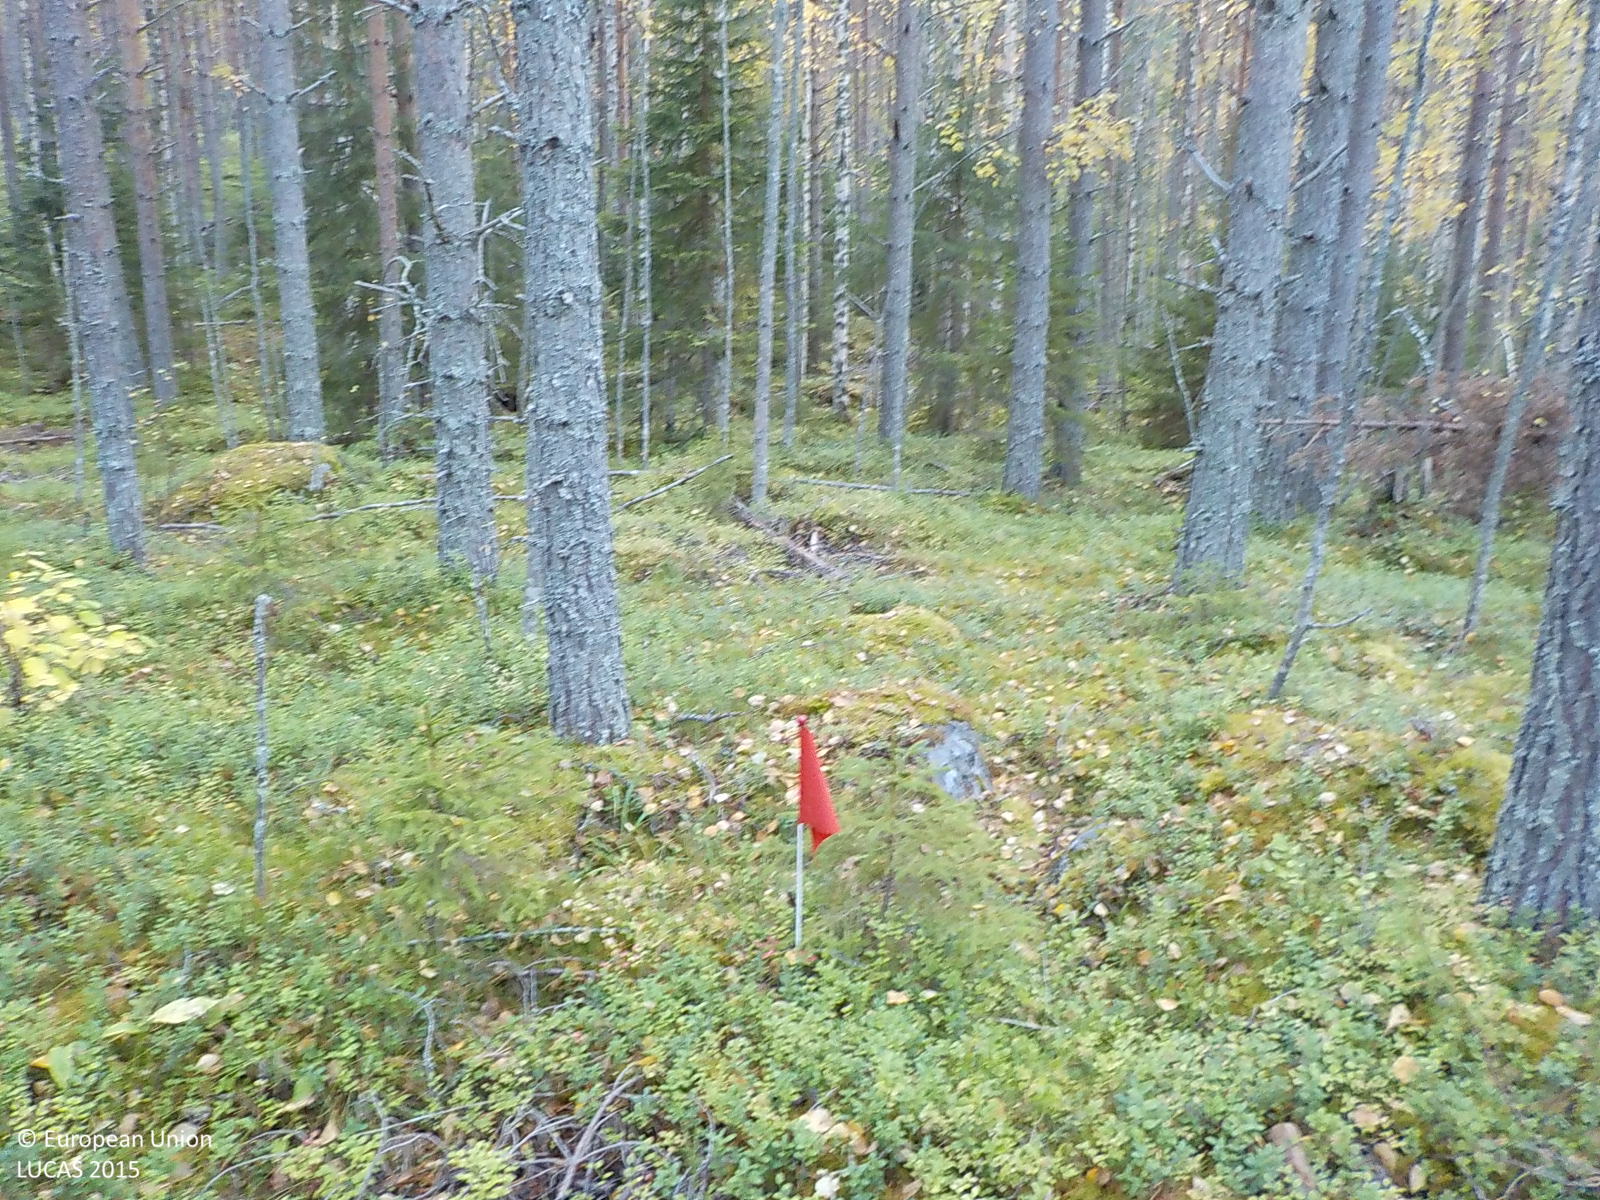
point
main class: Woodland
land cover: Pine dominated coniferous woodland
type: boreal forest
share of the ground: 50 - 75 %
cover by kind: coniferous forest trees 75 %, shrubs 25 %
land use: Forestry
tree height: > 5 m
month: September
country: SE
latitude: 63.4795
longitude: 17.0597
